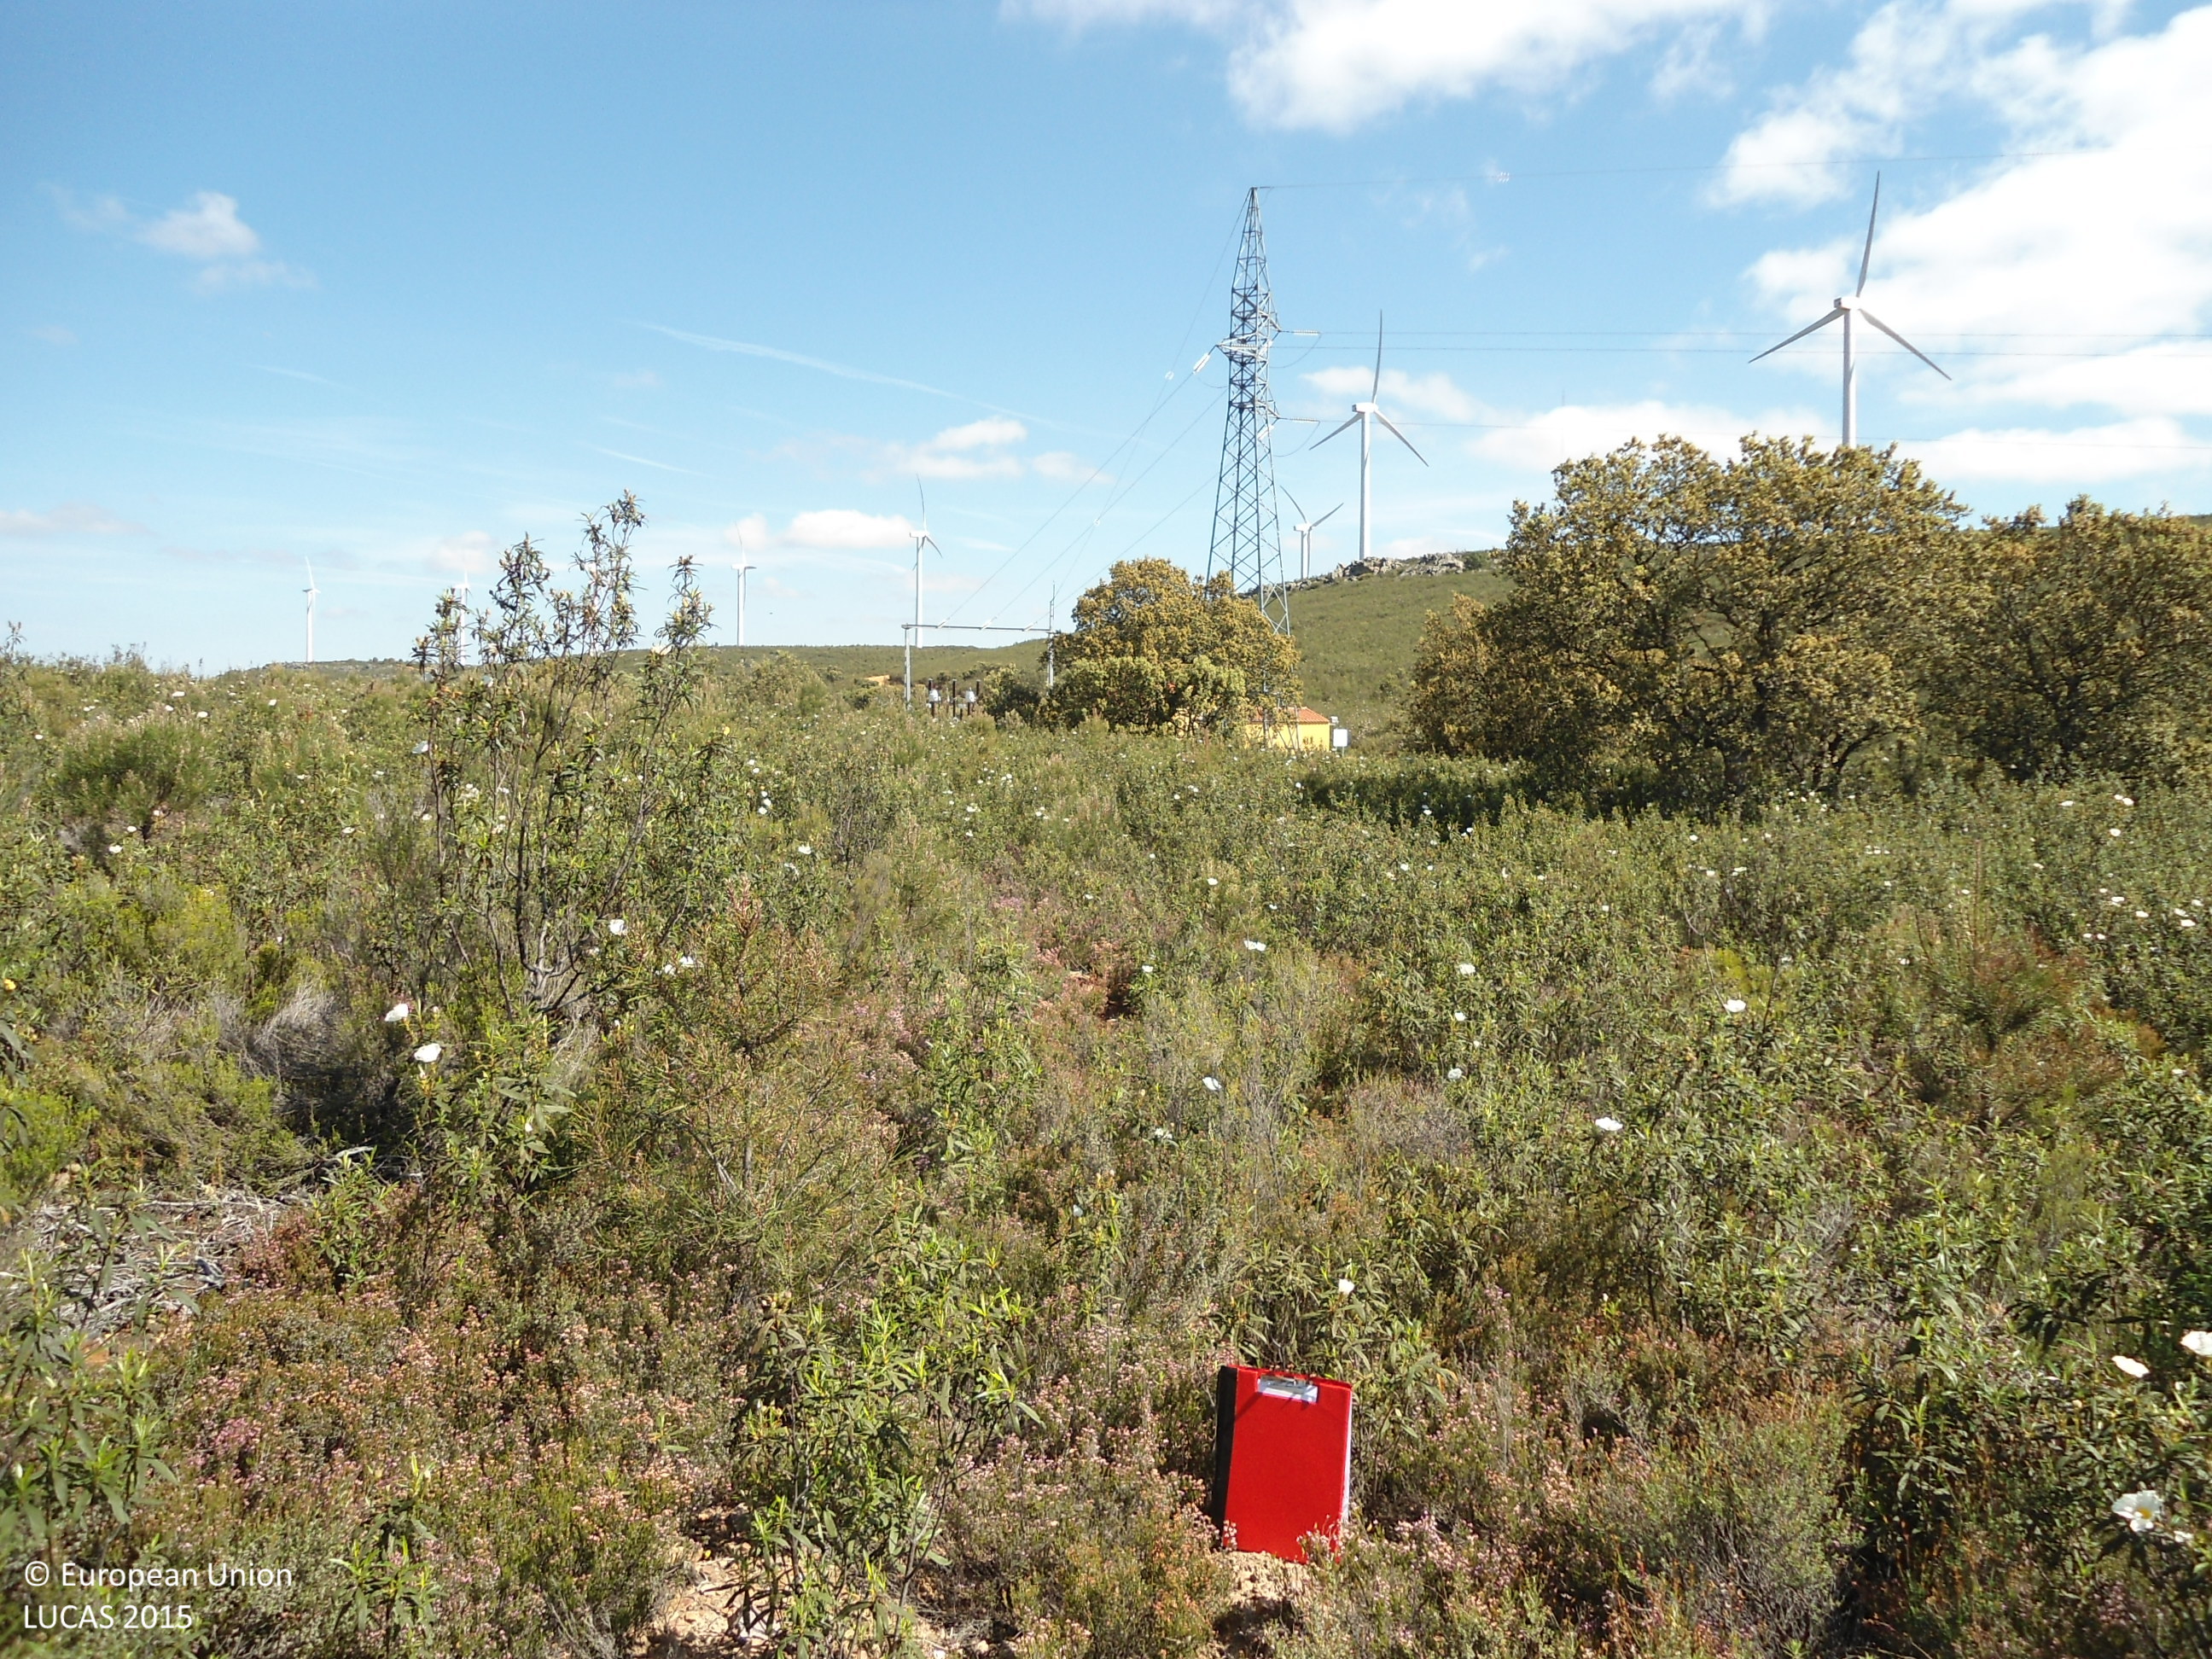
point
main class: Shrubland
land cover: Shrubland without tree cover
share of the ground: > 75 %
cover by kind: shrubs 100 %
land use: Semi-natural and natural areas not in use
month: May
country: ES
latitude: 41.8643
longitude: -5.9129
